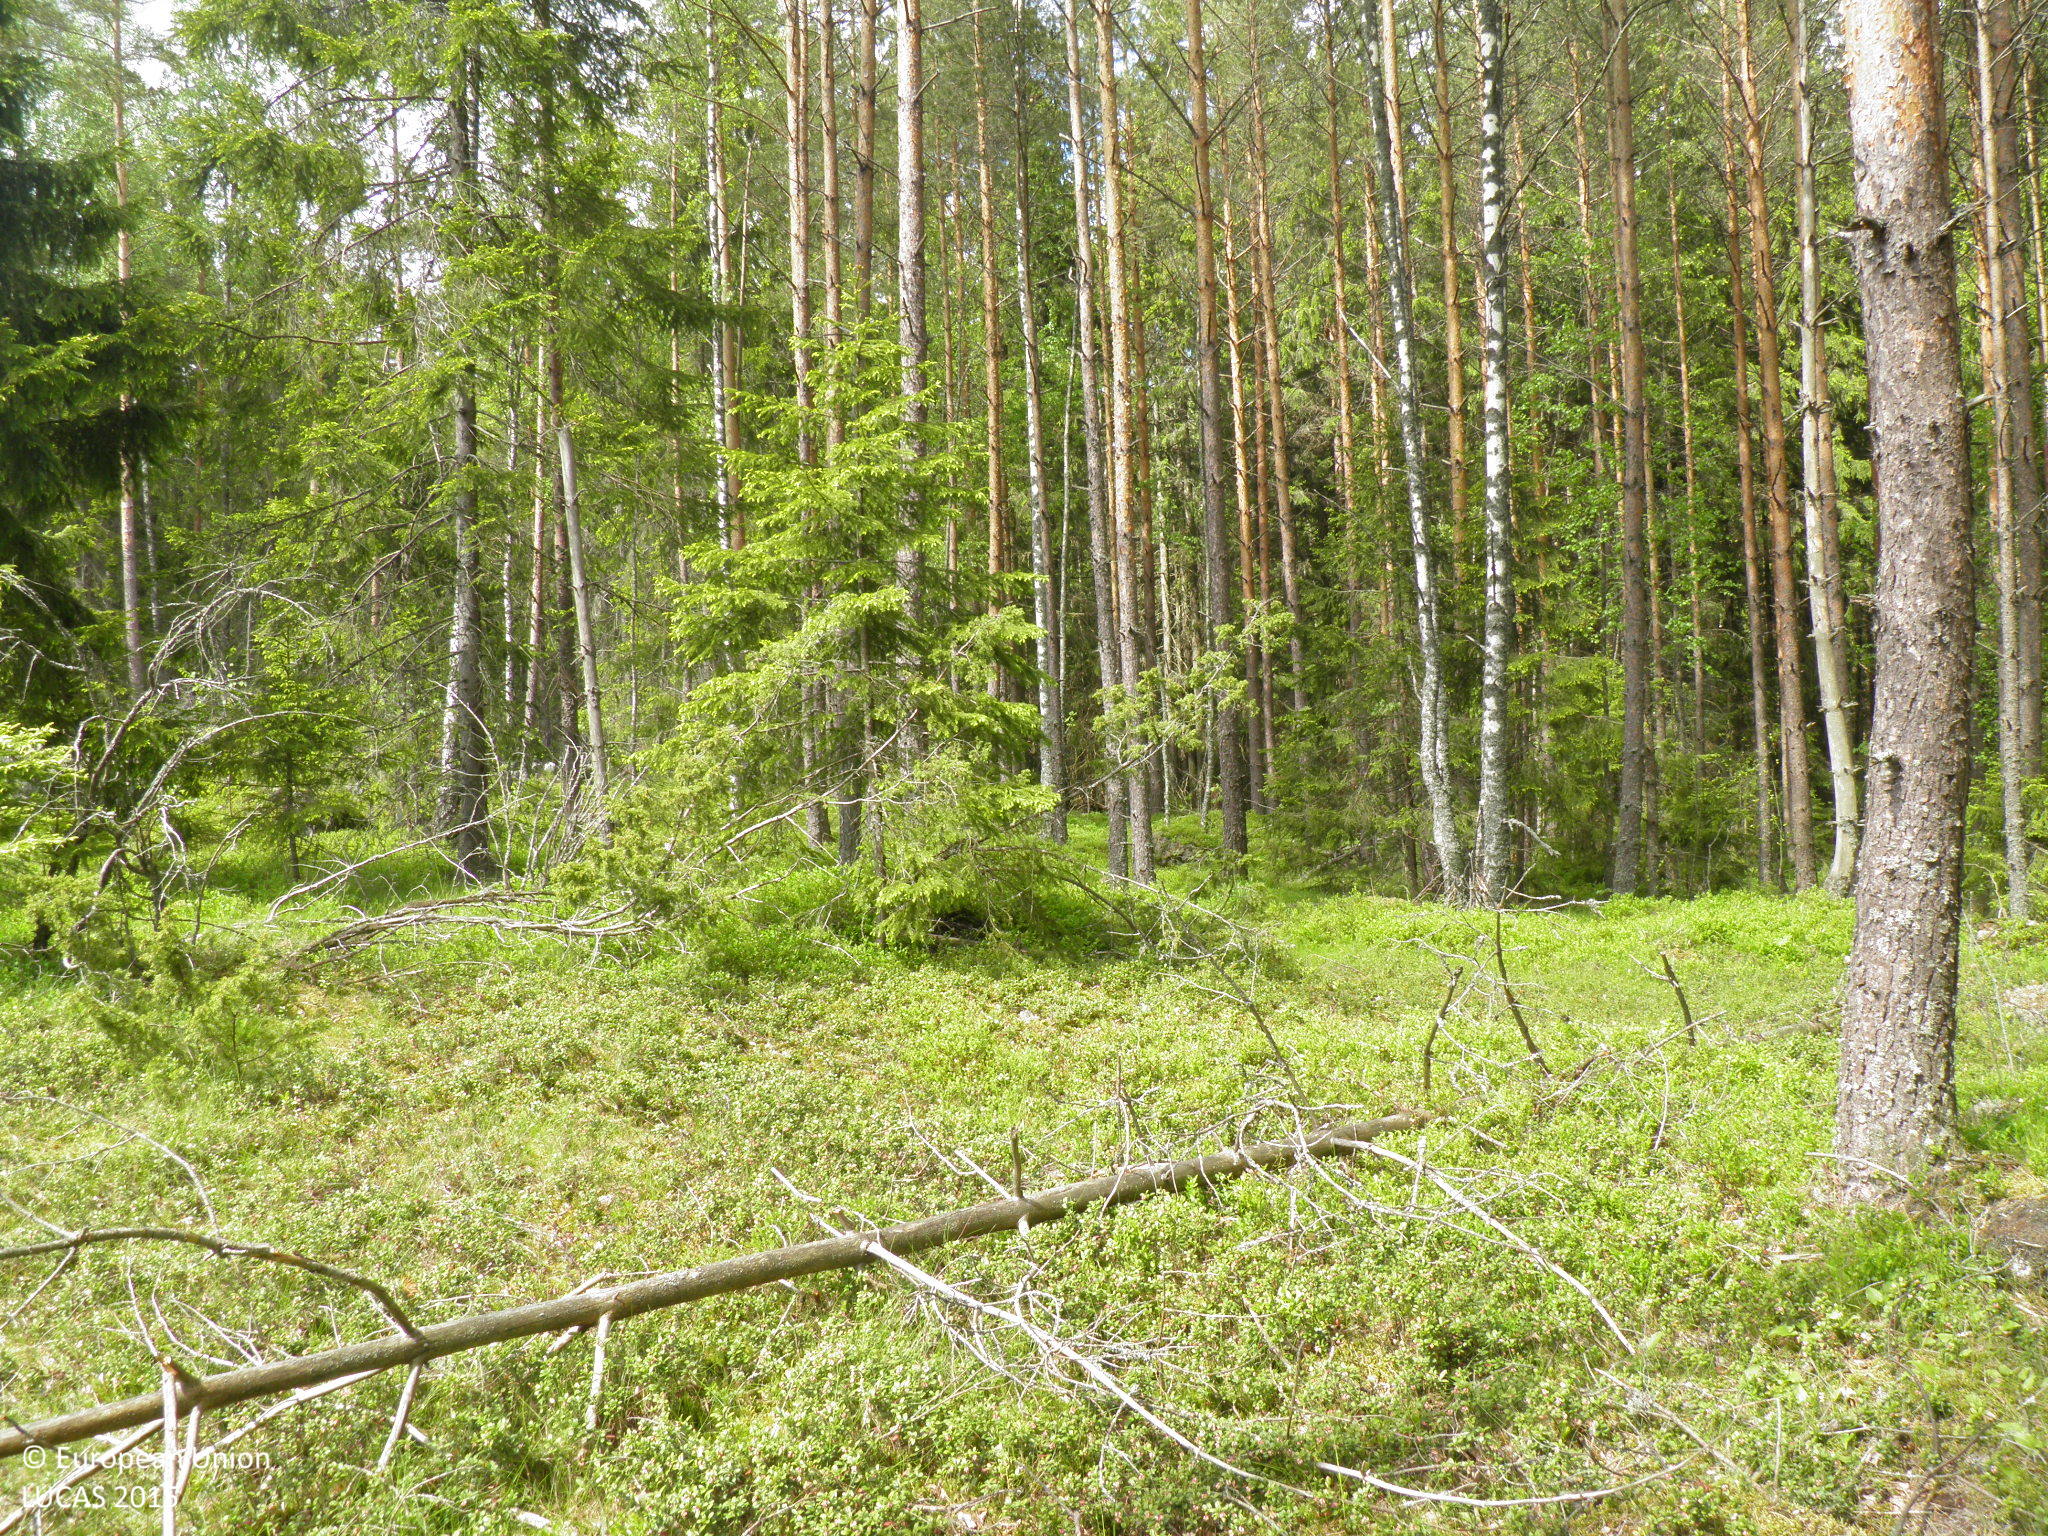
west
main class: Woodland
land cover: Pine dominated mixed woodland
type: hemiboreal forest and nemoral coniferous forest and mixed broadleaved-coniferous forest
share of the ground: > 75 %
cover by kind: coniferous forest trees 60 %, broadleaved forest trees 20 %, herbaceous plants 15 %, shrubs 5 %
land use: Forestry
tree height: > 5 m
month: June
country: FI
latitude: 60.5978
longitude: 22.6164
